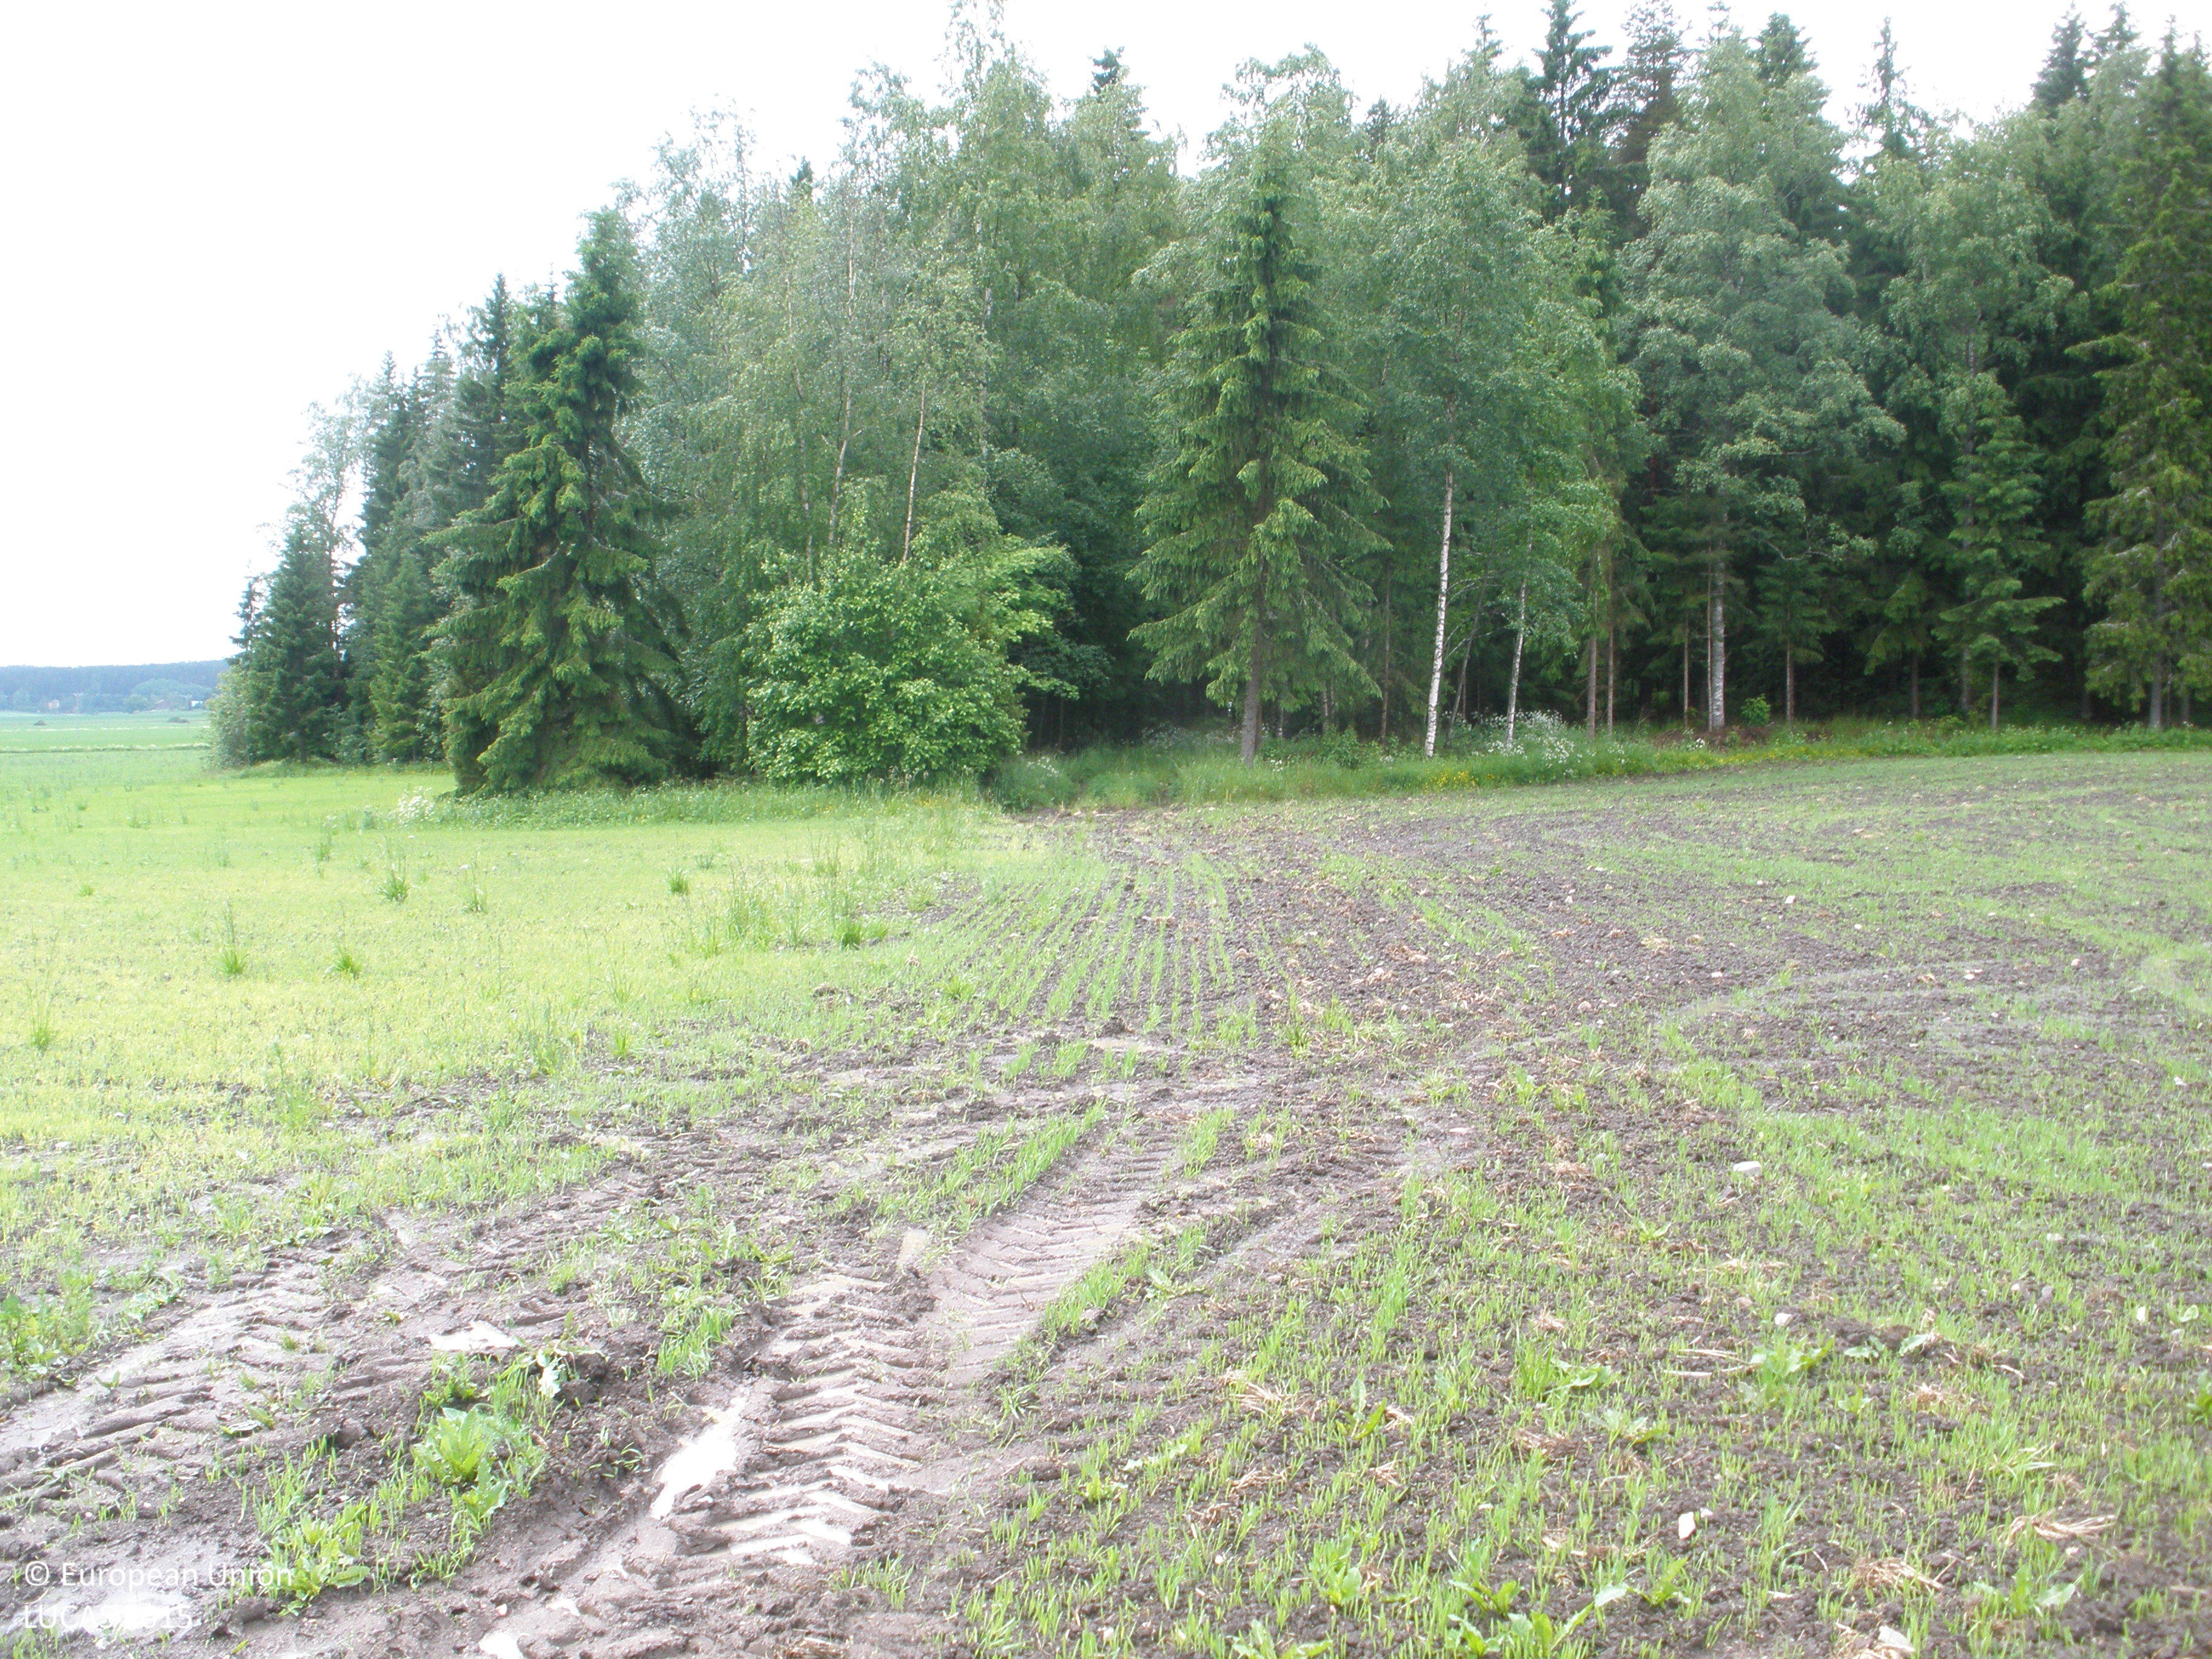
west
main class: Cropland
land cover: Oats
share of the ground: 25 - 50 %
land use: Agriculture (excluding fallow land and kitchen gardens)
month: June
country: FI
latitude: 60.8142
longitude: 23.4485
